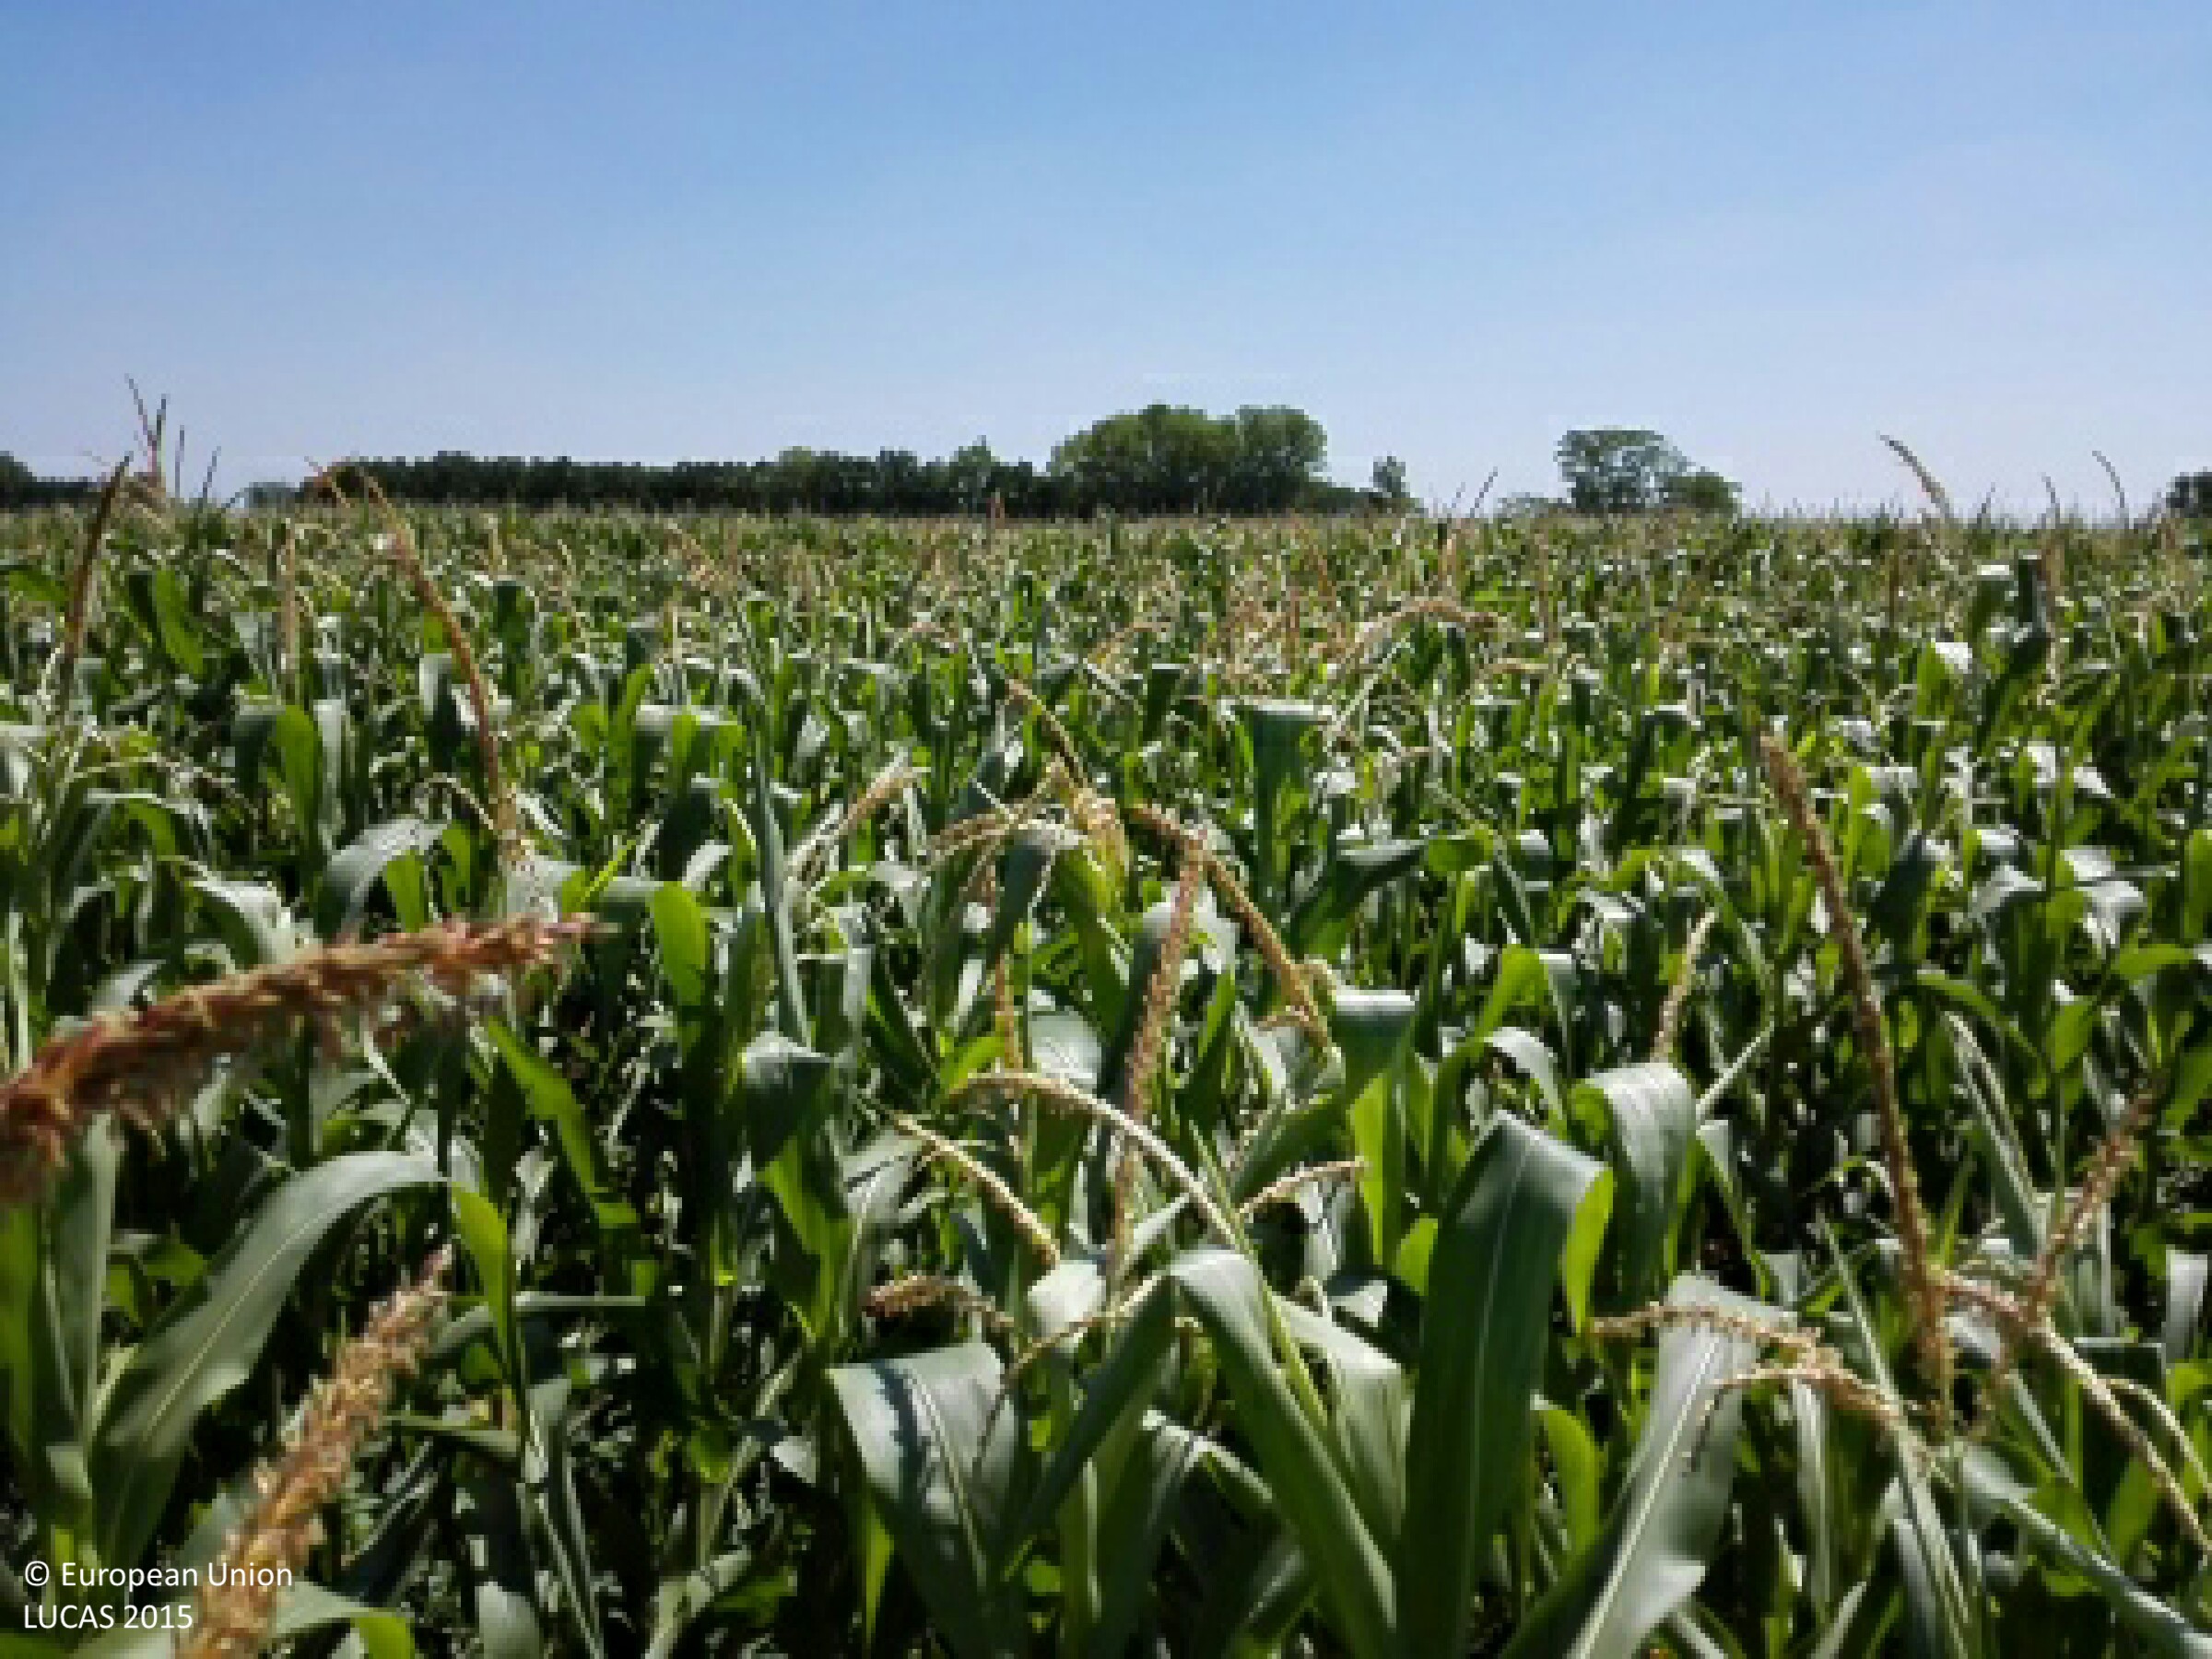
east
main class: Cropland
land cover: Maize
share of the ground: > 75 %
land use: Agriculture (excluding fallow land and kitchen gardens)
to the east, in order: Maize; Grass margins; Tracks; Maize; Lucerne
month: July
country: HU
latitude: 47.7755
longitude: 21.3994
